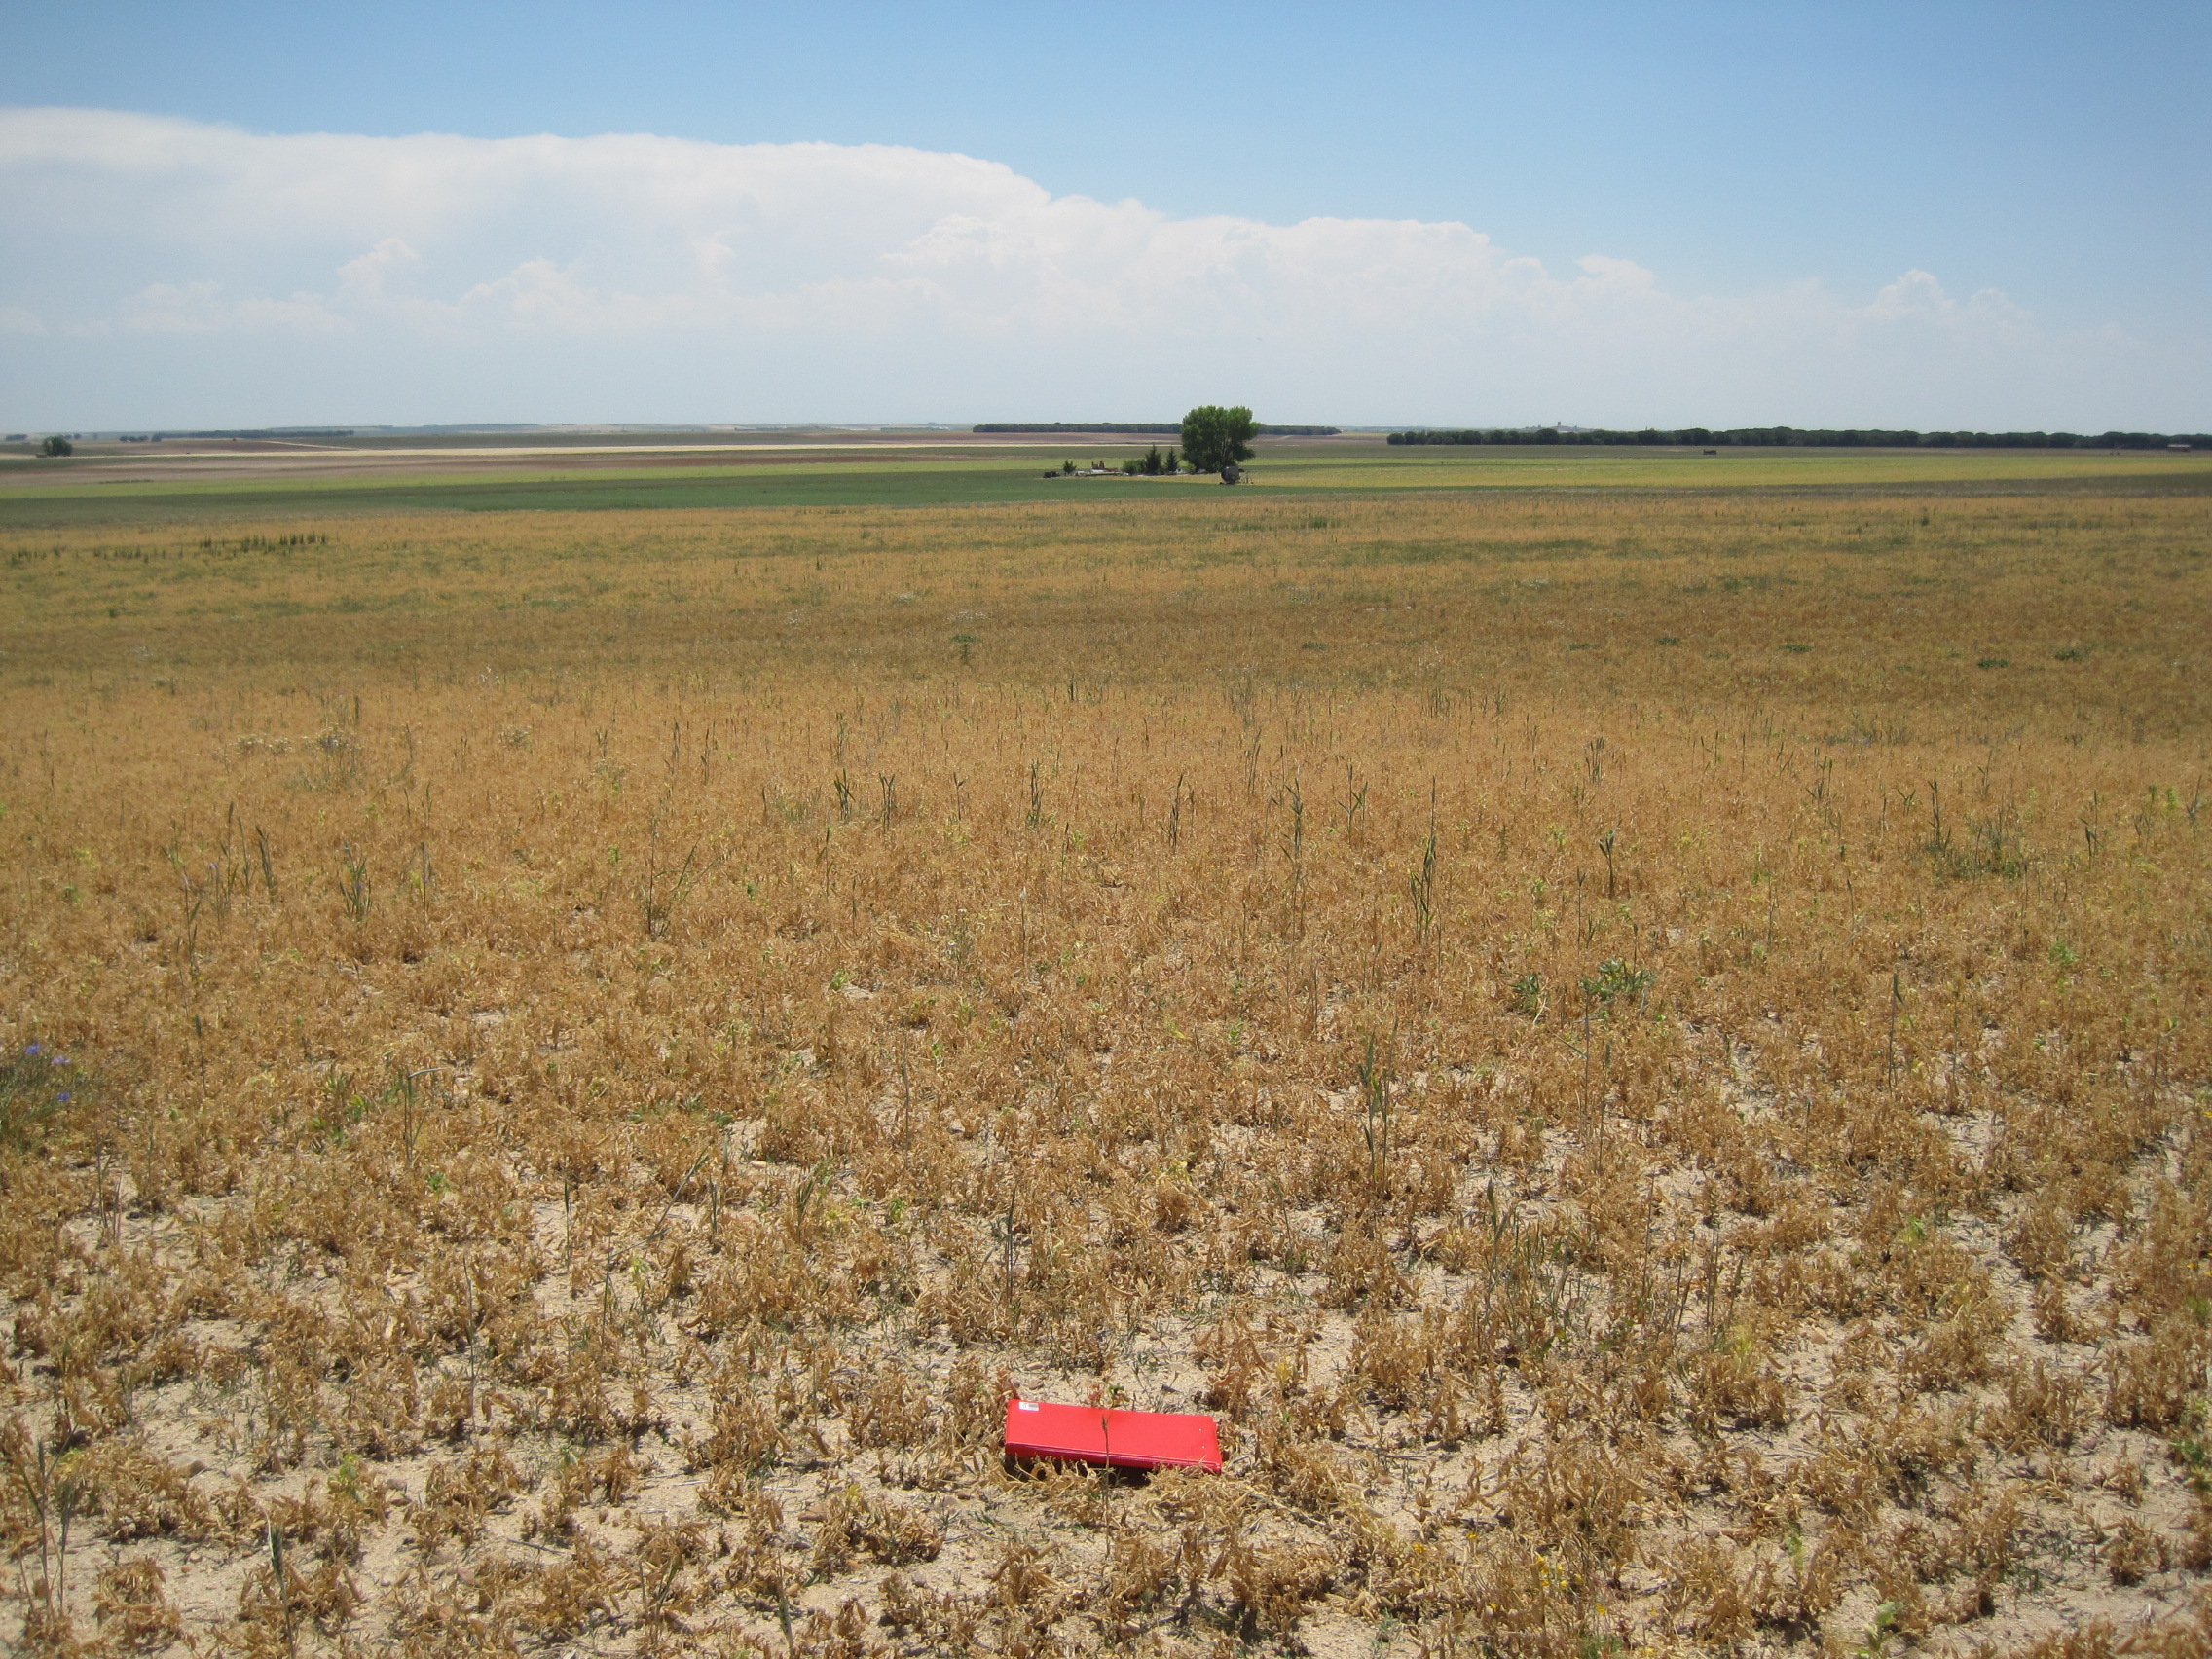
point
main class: Cropland
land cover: Dry pulses
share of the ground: > 75 %
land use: Agriculture (excluding fallow land and kitchen gardens)
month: May
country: ES
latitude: 41.2758
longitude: -5.1013
